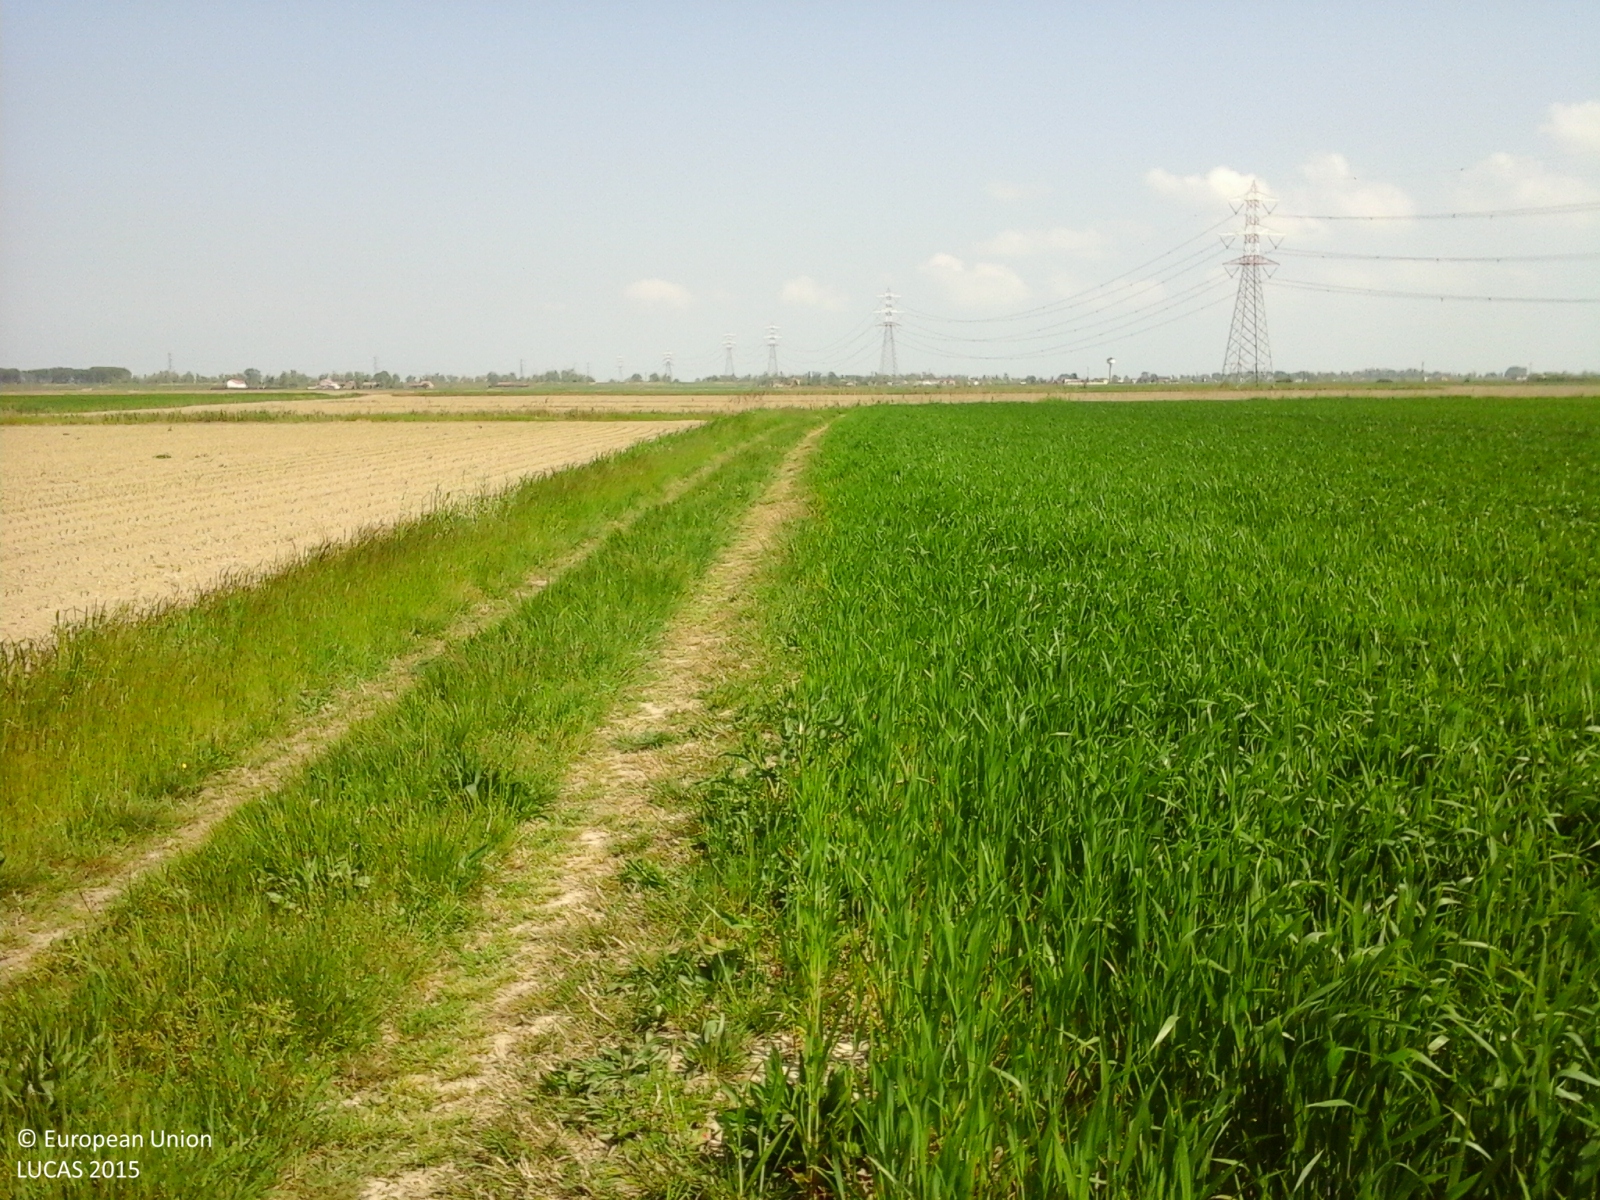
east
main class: Cropland
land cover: Common wheat
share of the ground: > 75 %
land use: Agriculture (excluding fallow land and kitchen gardens)
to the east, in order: Common wheat; Tracks; Grass margins; Ditches and canals; Grass margins; Tracks; Grass margins; Inland fresh running water; Grass margins; Tracks; Ditches and canals; Maize; Ditches and canals; Maize; Ditches and canals; Maize
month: April
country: IT
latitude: 44.9026
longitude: 12.2880
